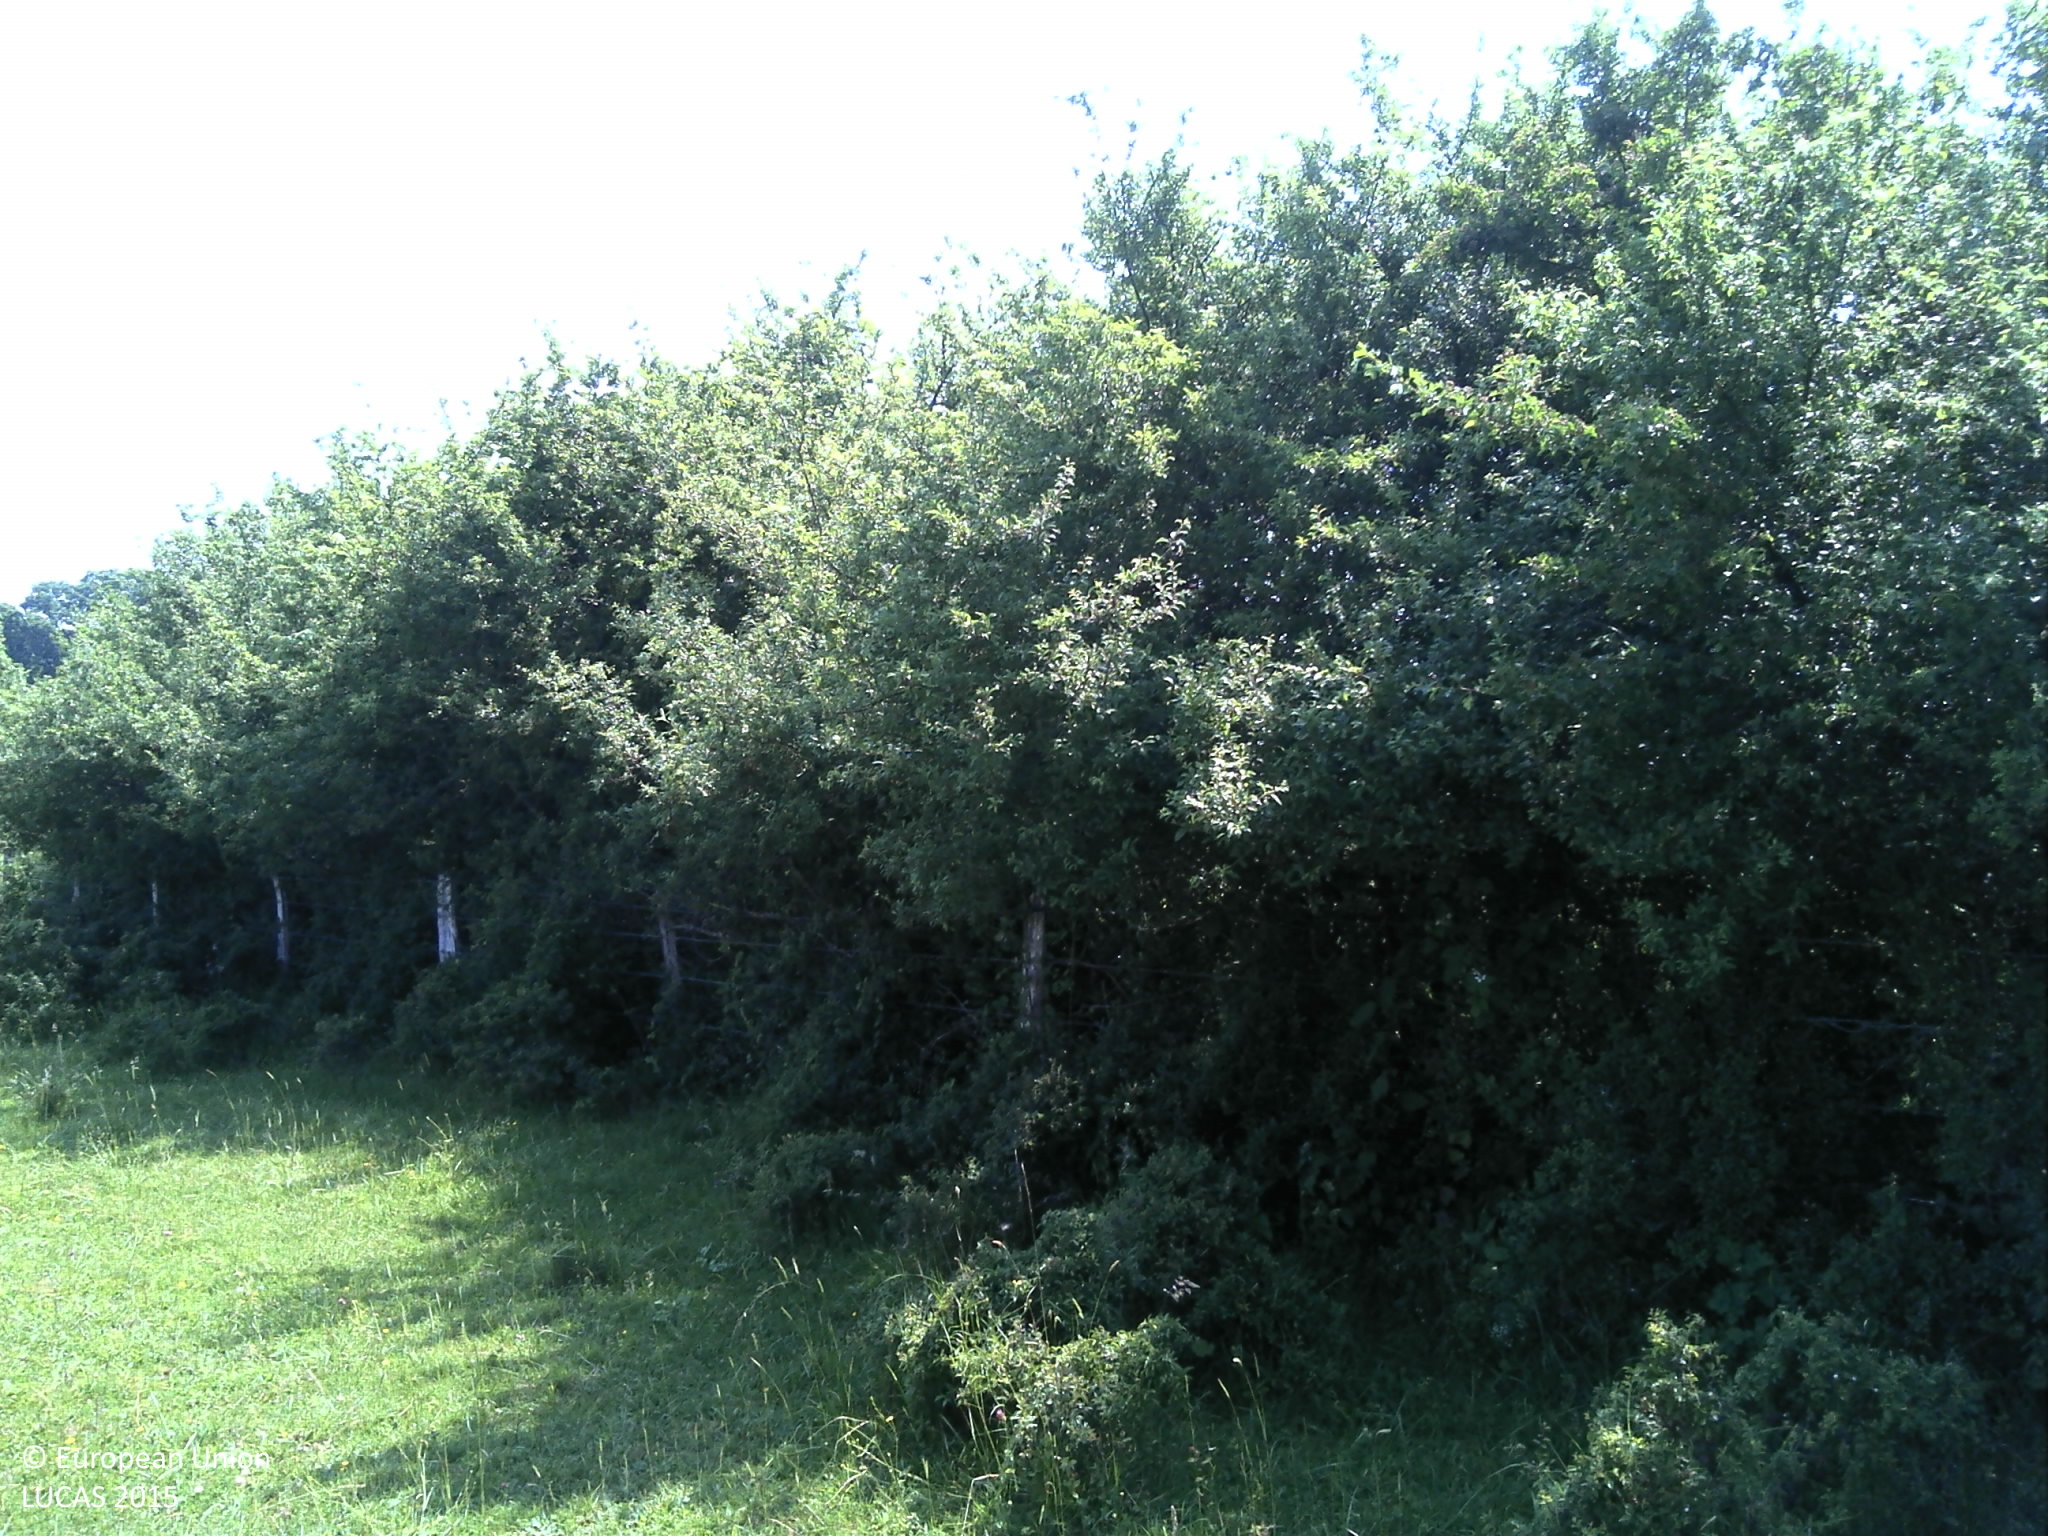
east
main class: Grassland
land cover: Grassland without tree/shrub cover
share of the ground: > 75 %
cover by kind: herbaceous plants 100 %
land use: Agriculture (excluding fallow land and kitchen gardens)
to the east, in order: Grassland without tree/shrub cover; Fences; Abandoned hedges; Grass margins; Common wheat; Tracks; Common wheat
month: June
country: FR
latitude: 49.0590
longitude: 6.2090
